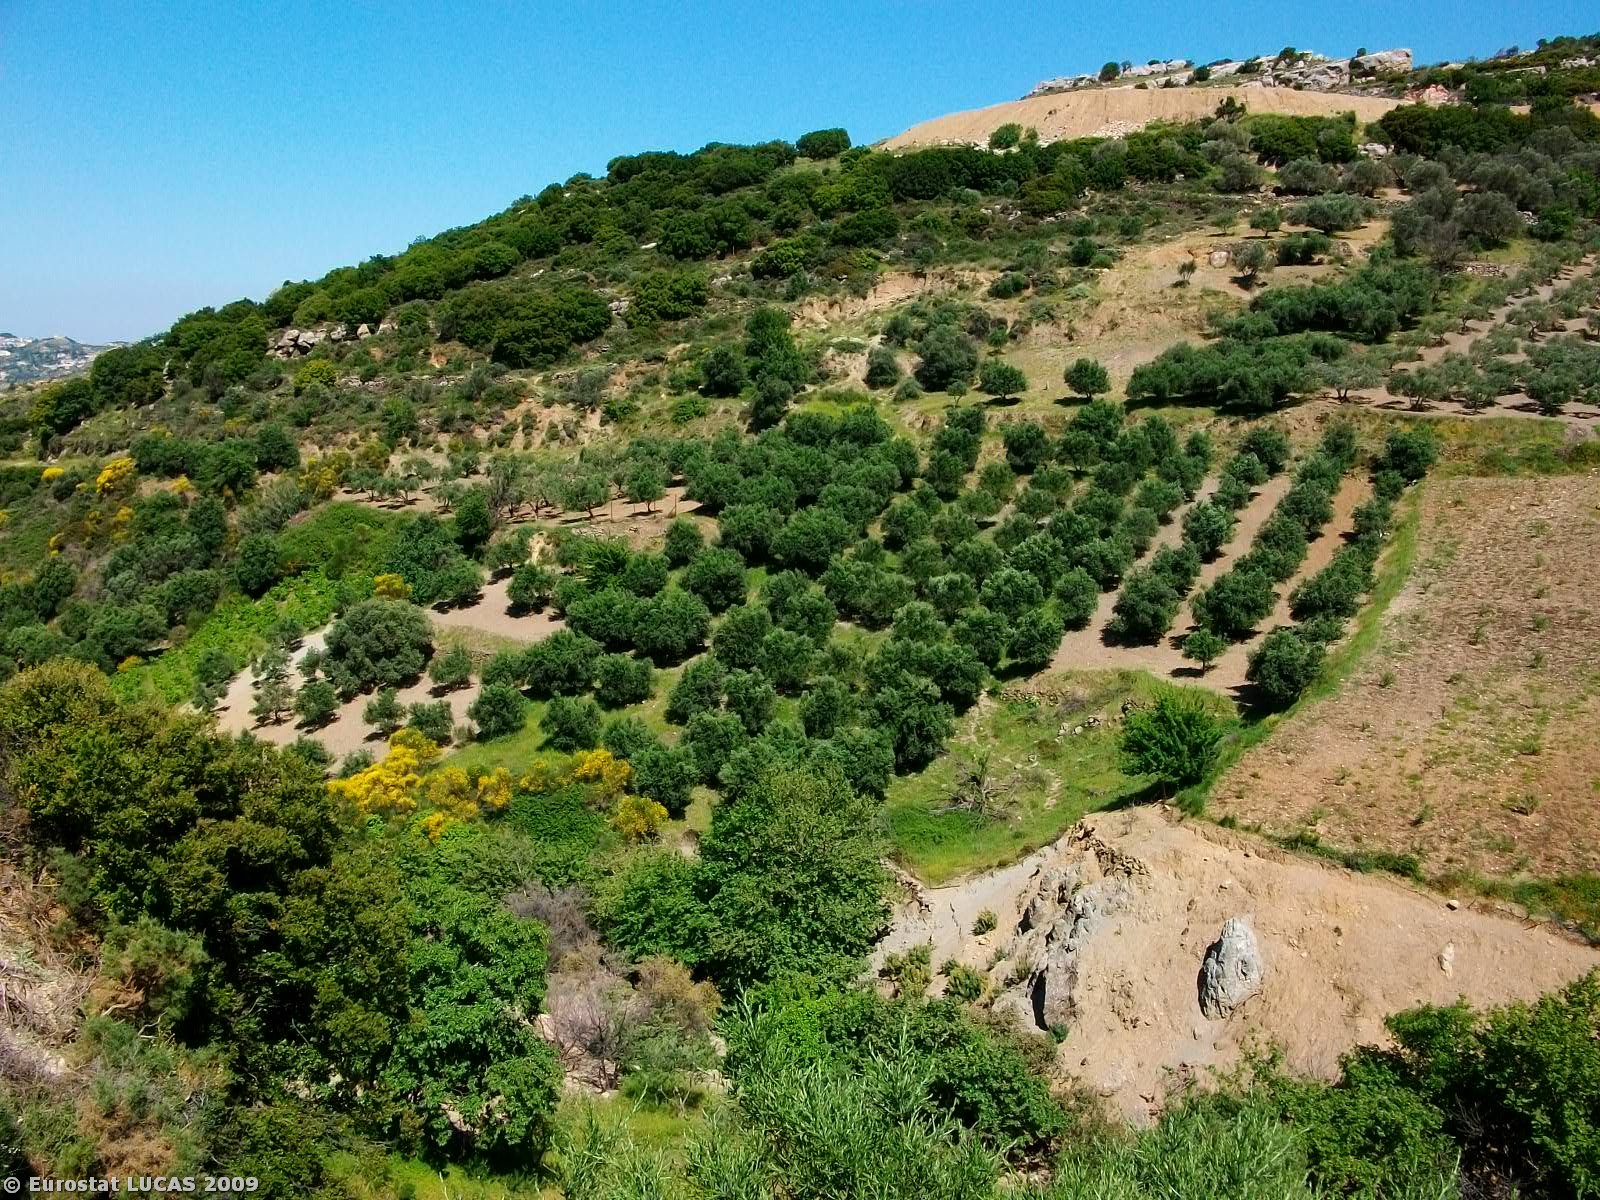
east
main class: Shrubland
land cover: Shrubland with sparse tree cover
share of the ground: 50 - 75 %
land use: Unused
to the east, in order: Shrubland with sparse tree cover; Fences; Olive groves; Bare land; Fences; Rivers and streams; Bare land; Fences; Vineyards; Bare land; Tracks; Olive groves; Bare land; Shrubland with sparse tree cover
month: May
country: GR
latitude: 35.2082
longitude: 24.9831
